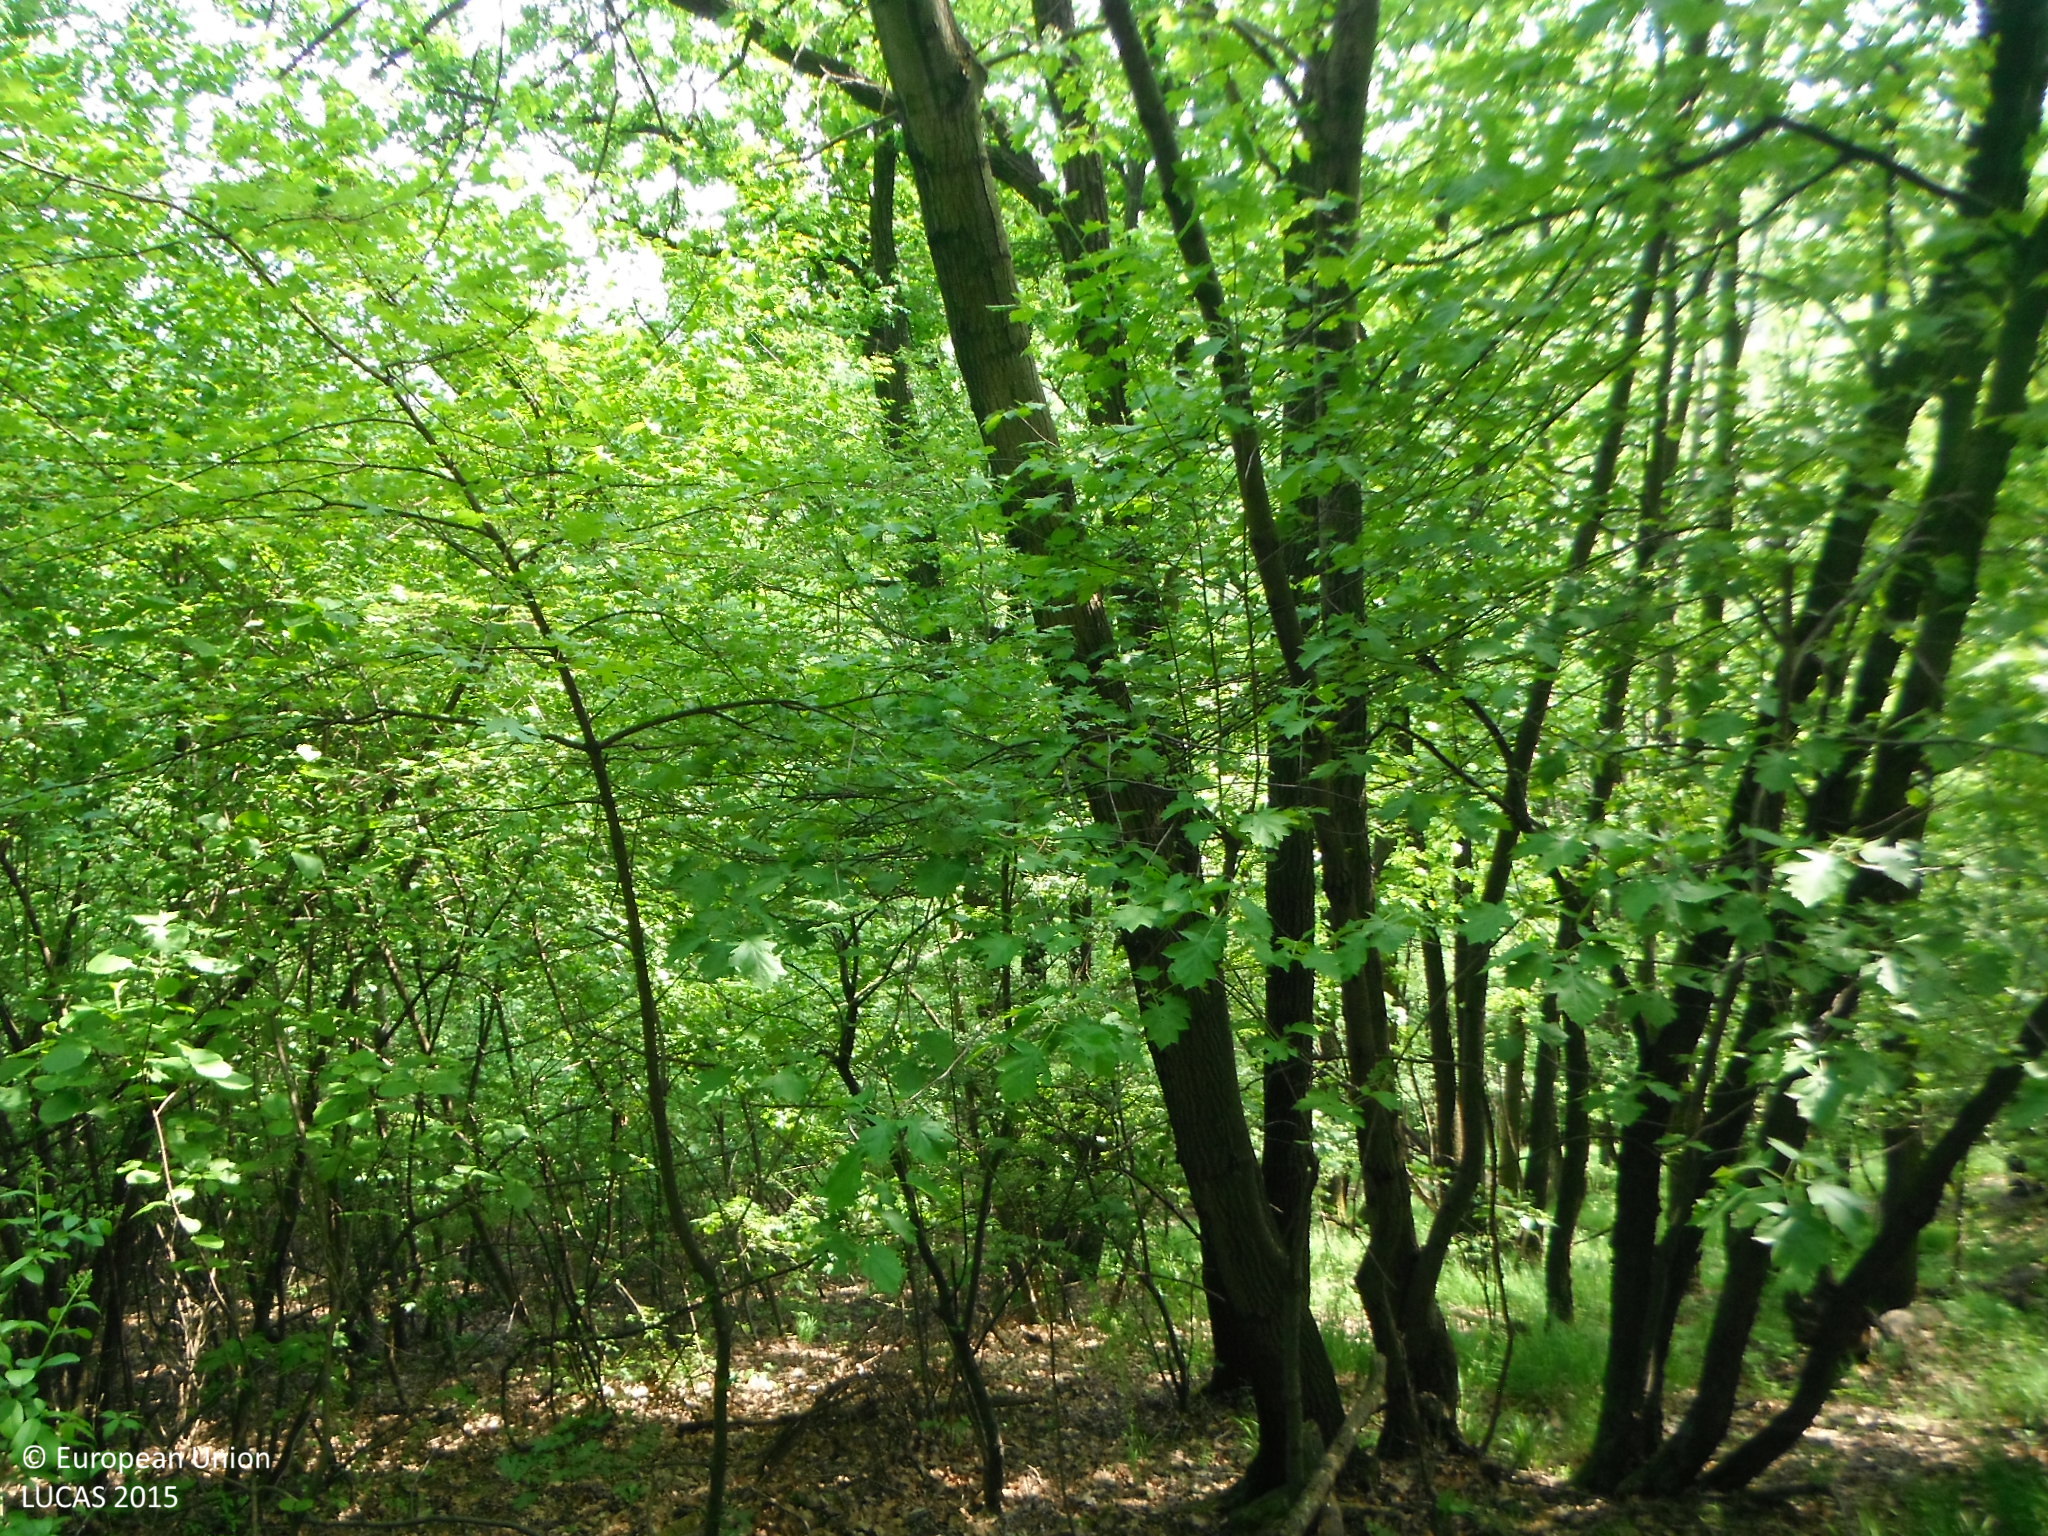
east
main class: Woodland
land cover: Broadleaved woodland
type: mesophytic deciduous forest
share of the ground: > 75 %
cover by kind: broadleaved forest trees 100 %
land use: Forestry
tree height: > 5 m
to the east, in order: Broadleaved woodland; Tracks; Grassland without tree/shrub cover; Broadleaved woodland
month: May
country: SK
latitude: 48.3593
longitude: 18.0982
